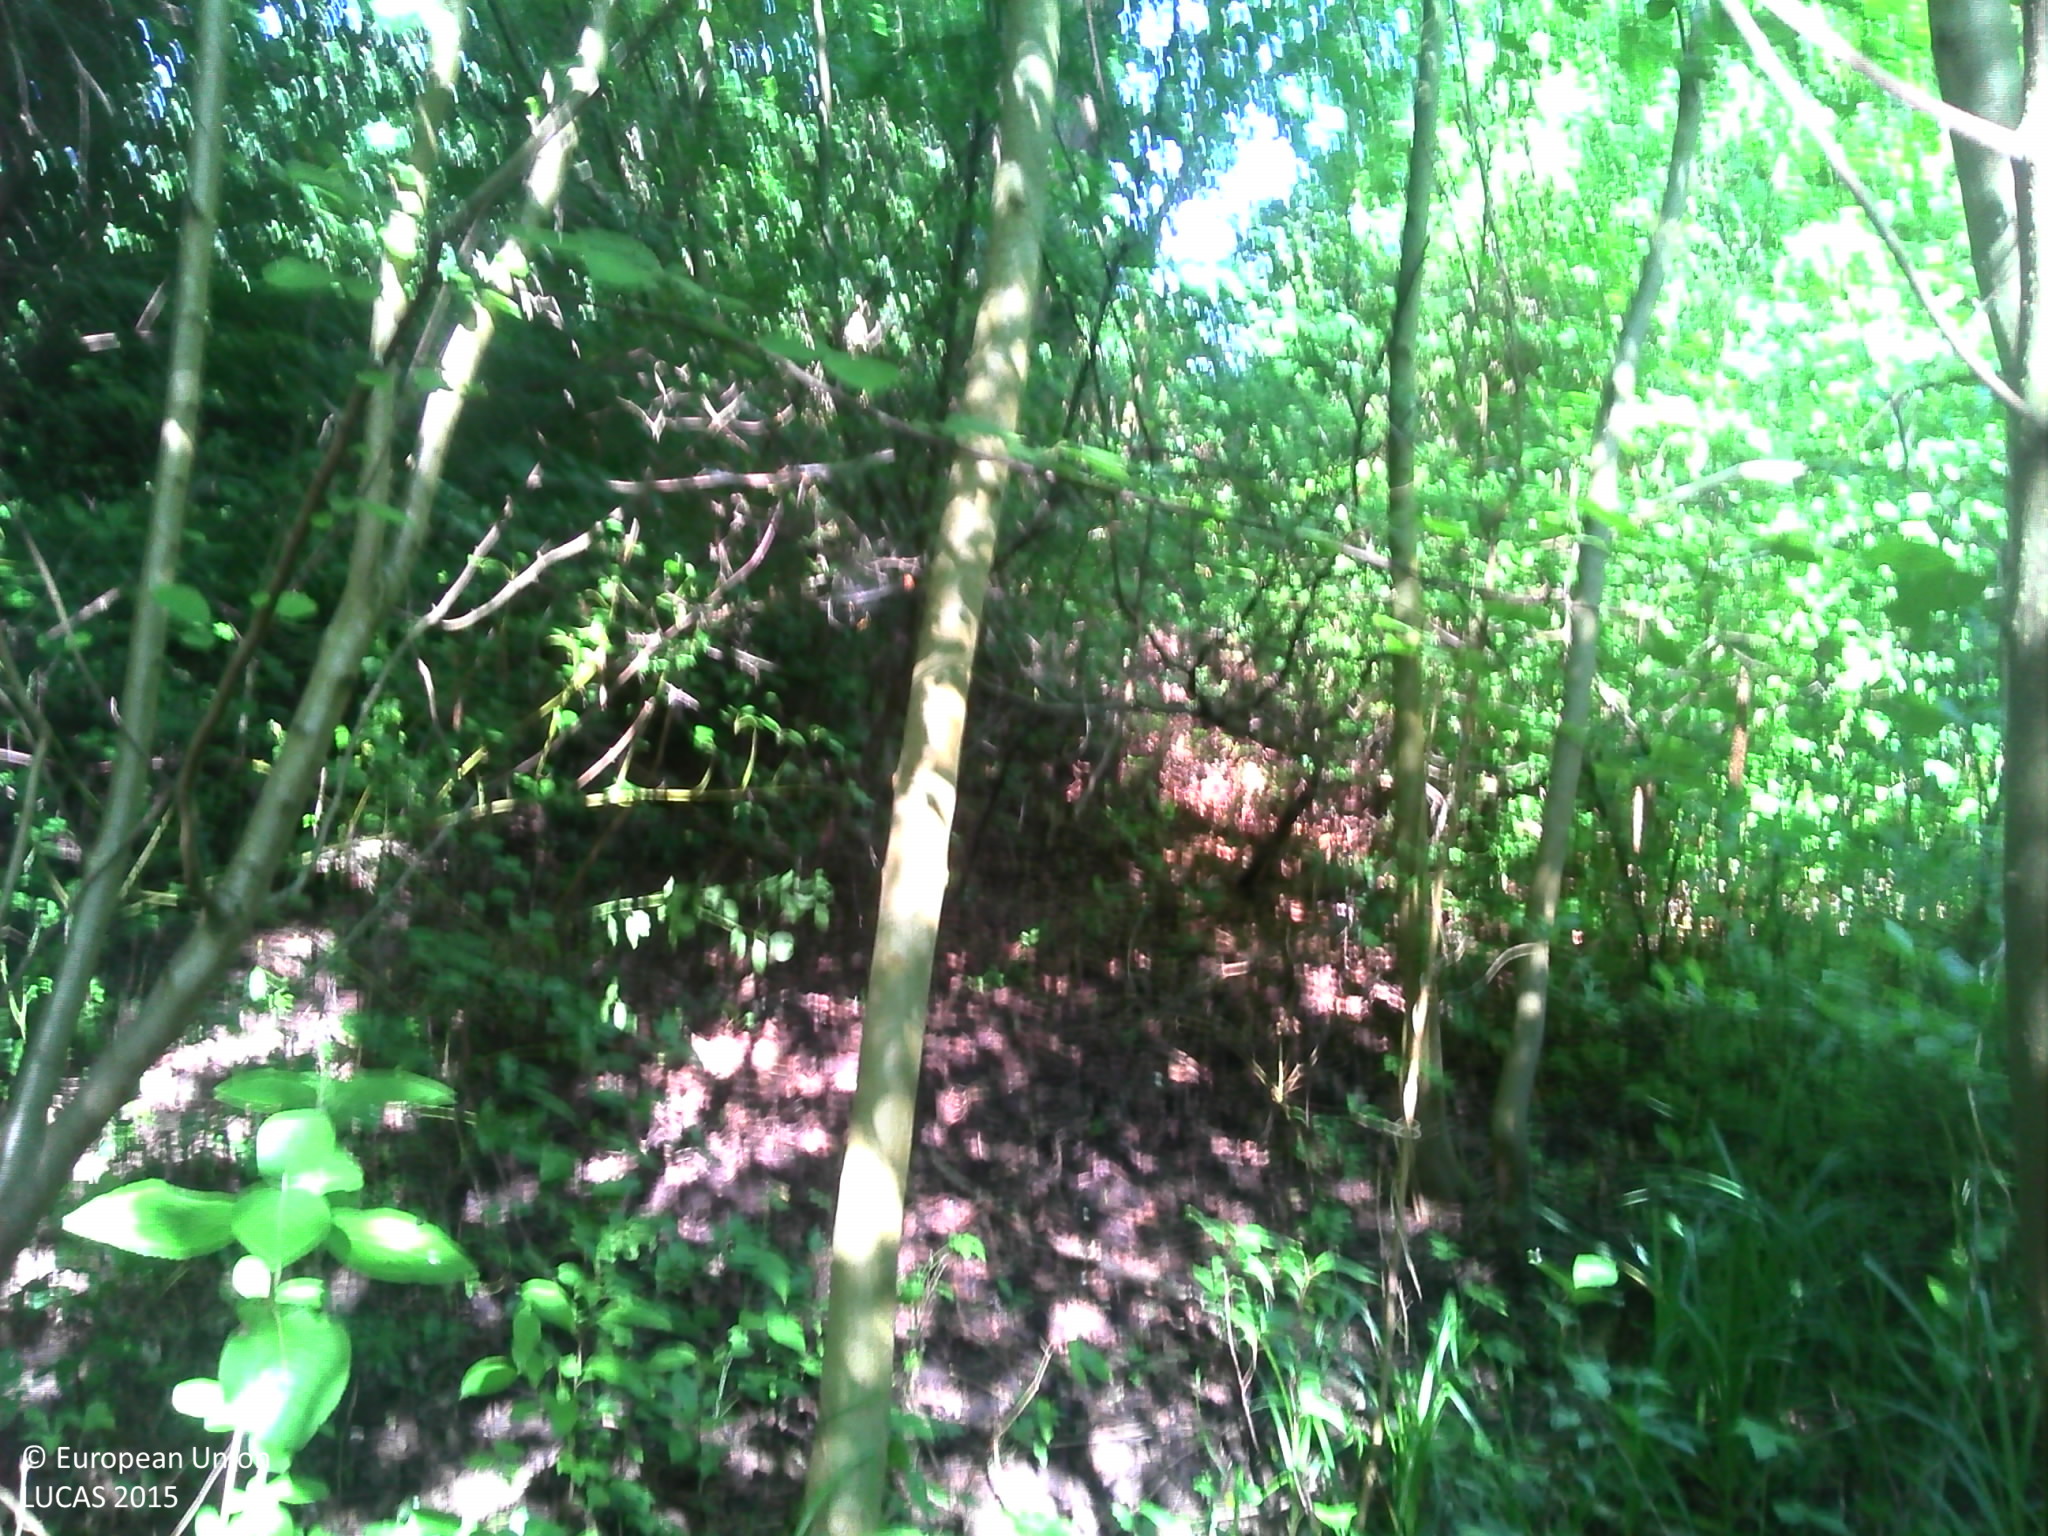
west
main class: Woodland
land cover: Broadleaved woodland
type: mesophytic deciduous forest
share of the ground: > 75 %
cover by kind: broadleaved forest trees 95 %, herbaceous plants 5 %
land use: Forestry
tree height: > 5 m
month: June
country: FR
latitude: 48.3620
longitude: 7.7199
